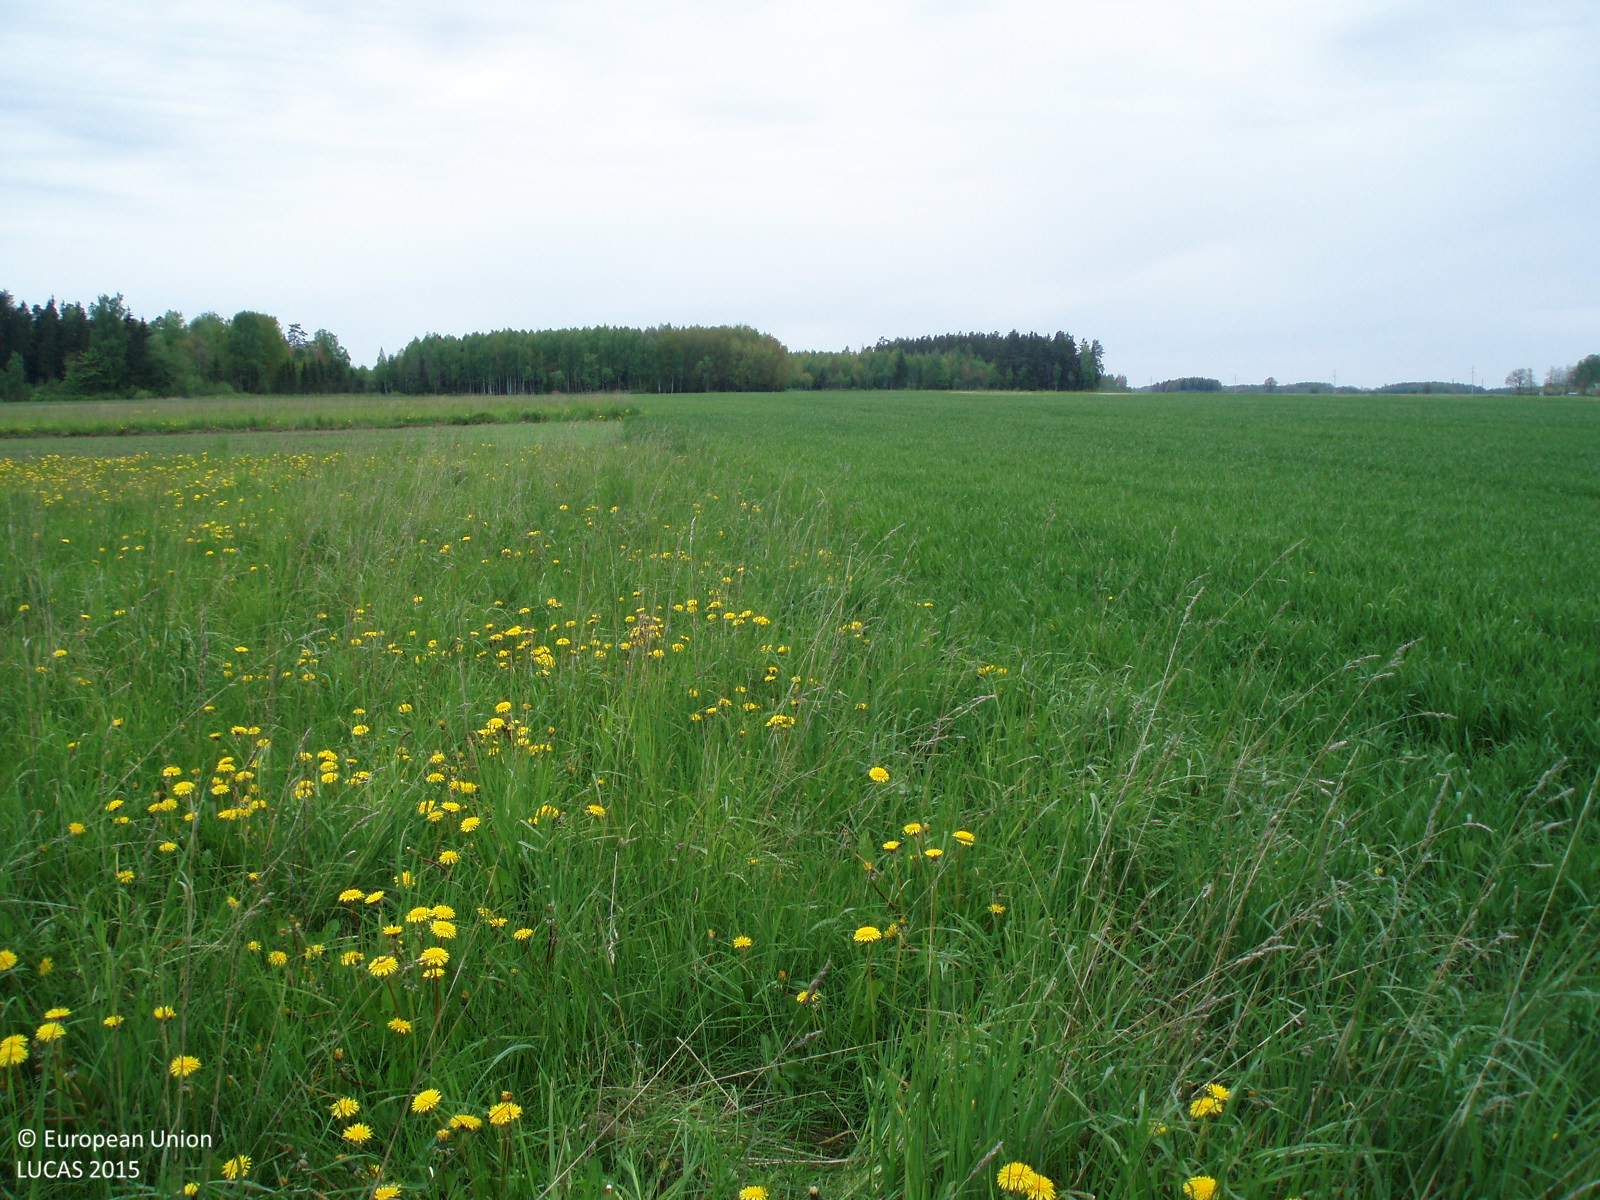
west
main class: Grassland
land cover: Grassland without tree/shrub cover
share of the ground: > 75 %
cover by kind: herbaceous plants 100 %
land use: Agriculture (excluding fallow land and kitchen gardens)
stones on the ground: < 10 %
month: May
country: LT
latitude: 56.3483
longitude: 22.4022
